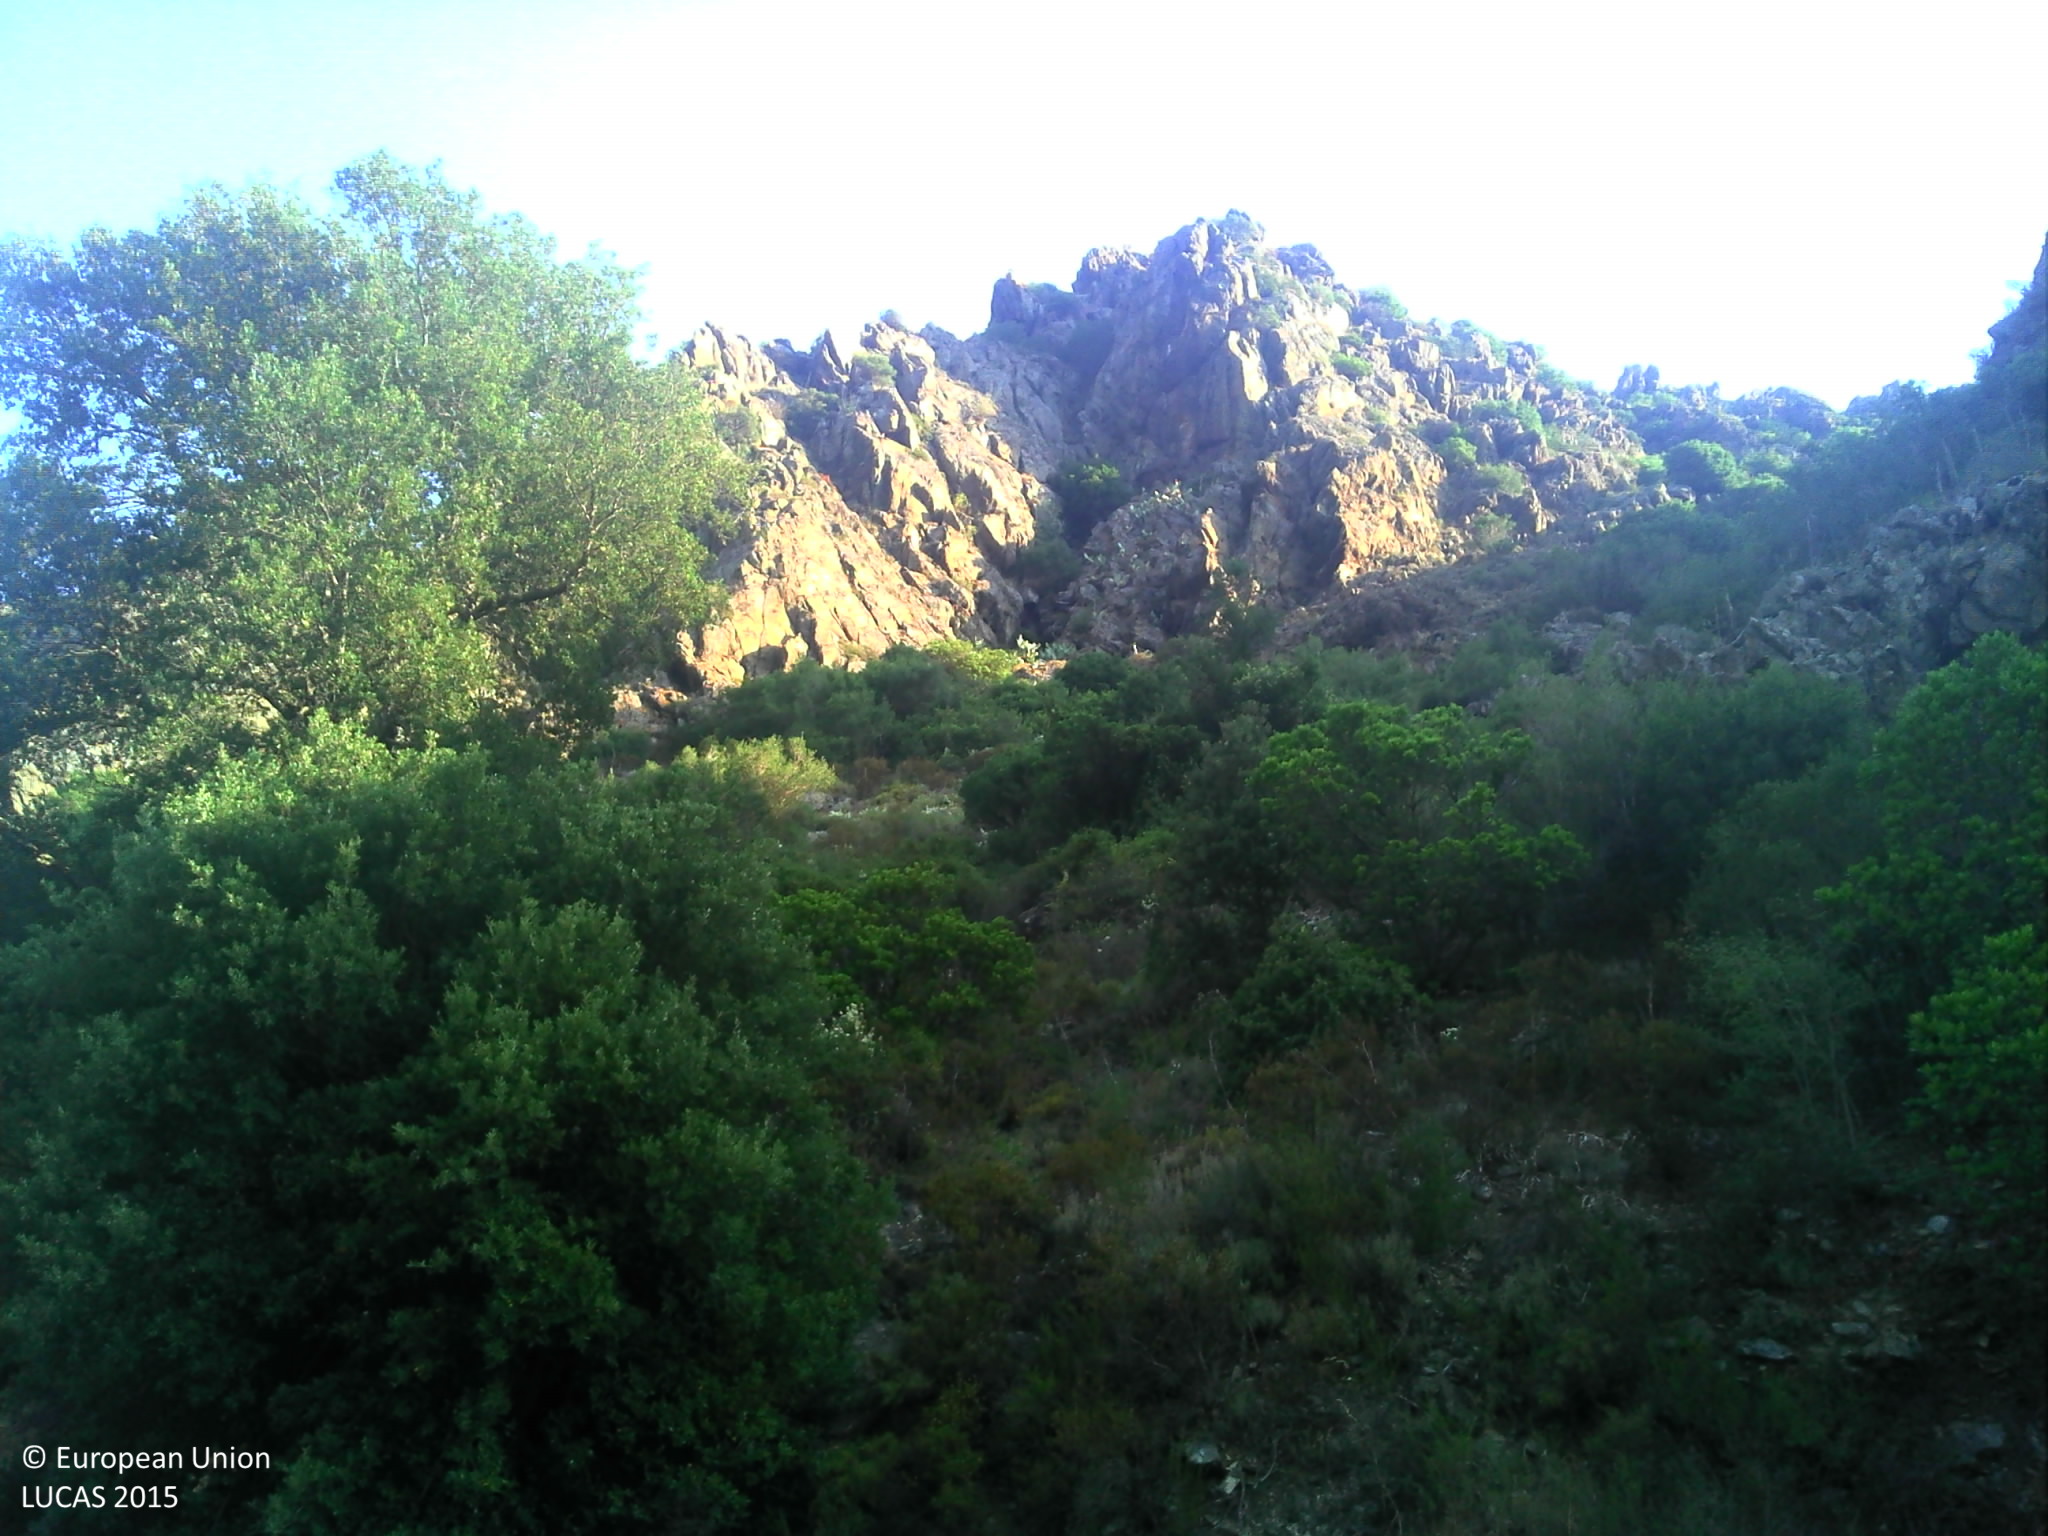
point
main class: Shrubland
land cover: Shrubland without tree cover
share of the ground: > 75 %
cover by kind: shrubs 80 %, consolidated bare surface 20 %
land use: Semi-natural and natural areas not in use
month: July
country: FR
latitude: 42.5073
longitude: 9.3330
